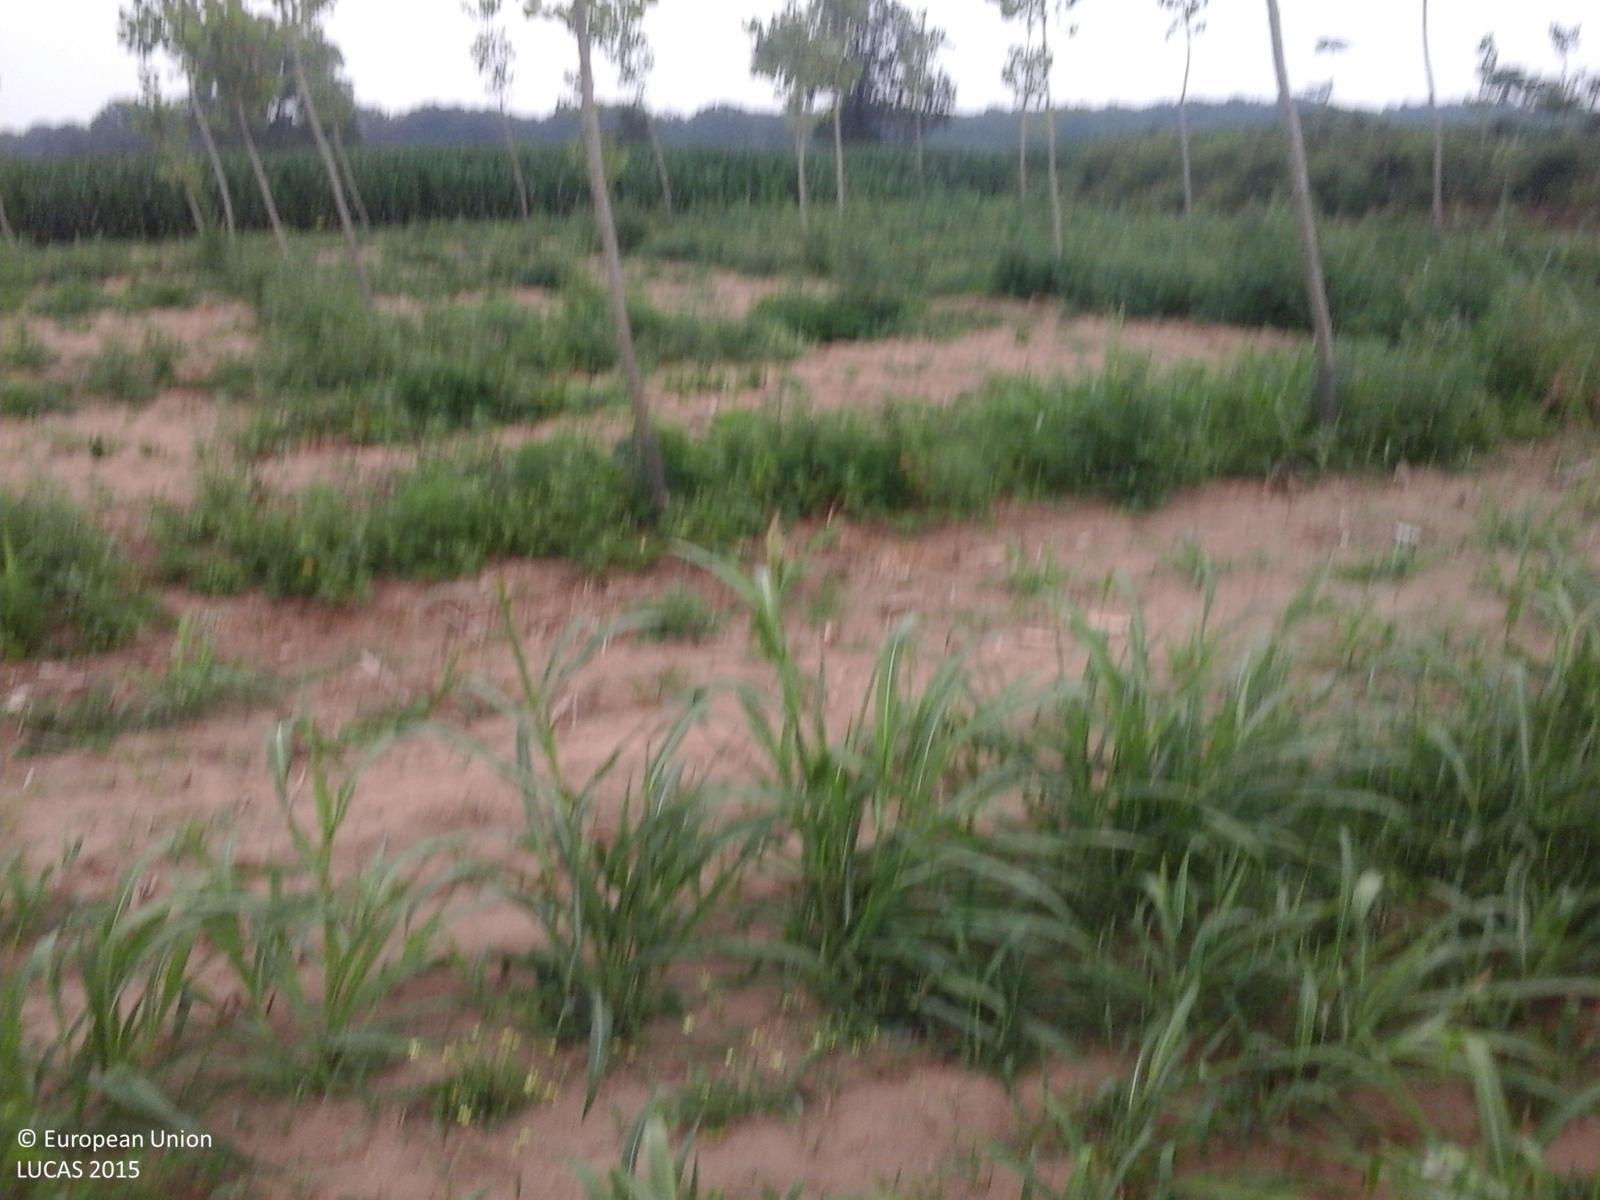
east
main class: Cropland
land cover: Maize
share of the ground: > 75 %
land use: Agriculture (excluding fallow land and kitchen gardens)
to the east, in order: Maize; Grass margins; Broadleaved woodland; Maize; Grass margins; Ditches and canals; Grass margins; Tracks; Grass margins; Ditches and canals; Other bare soil
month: June
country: IT
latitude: 45.2271
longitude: 8.7922
